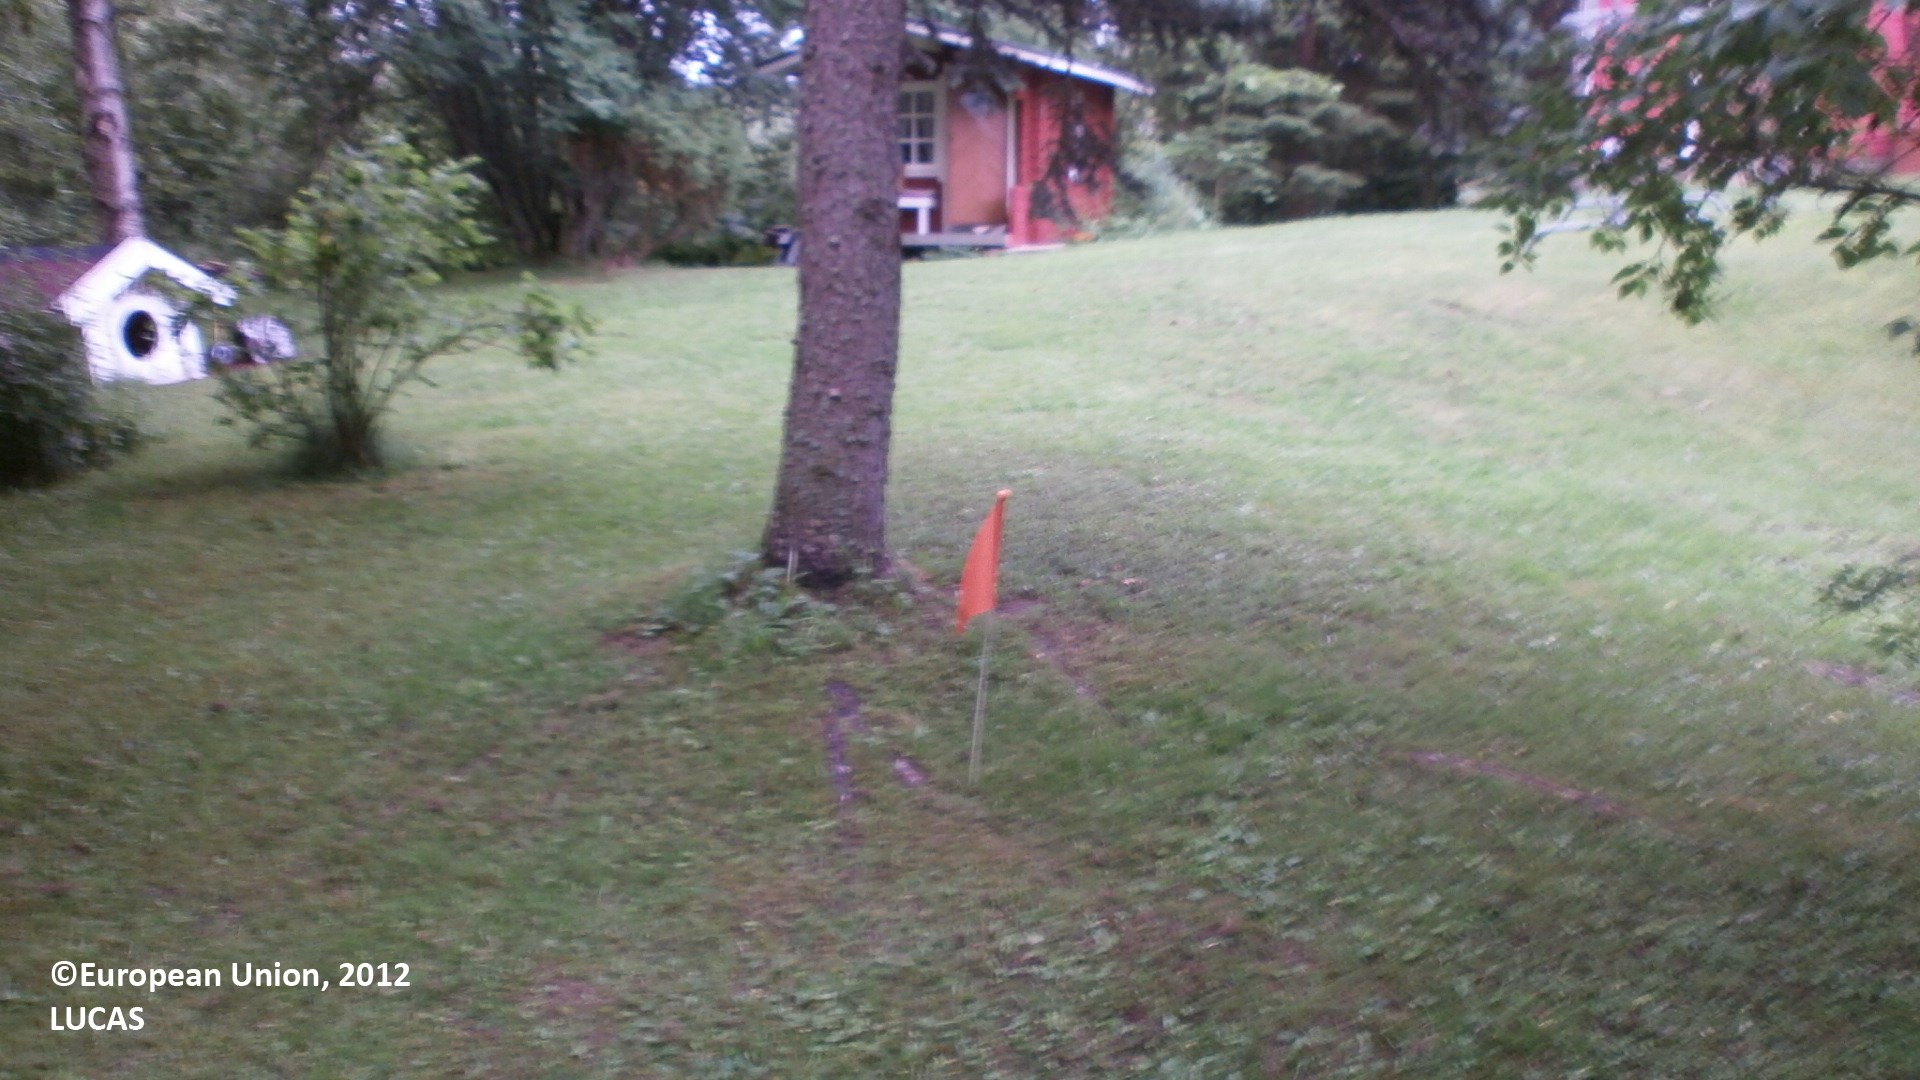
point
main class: Grassland
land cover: Grassland with sparse tree/shrub cover
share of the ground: > 75 %
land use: Residential
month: July
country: FI
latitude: 64.6777
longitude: 24.5904
